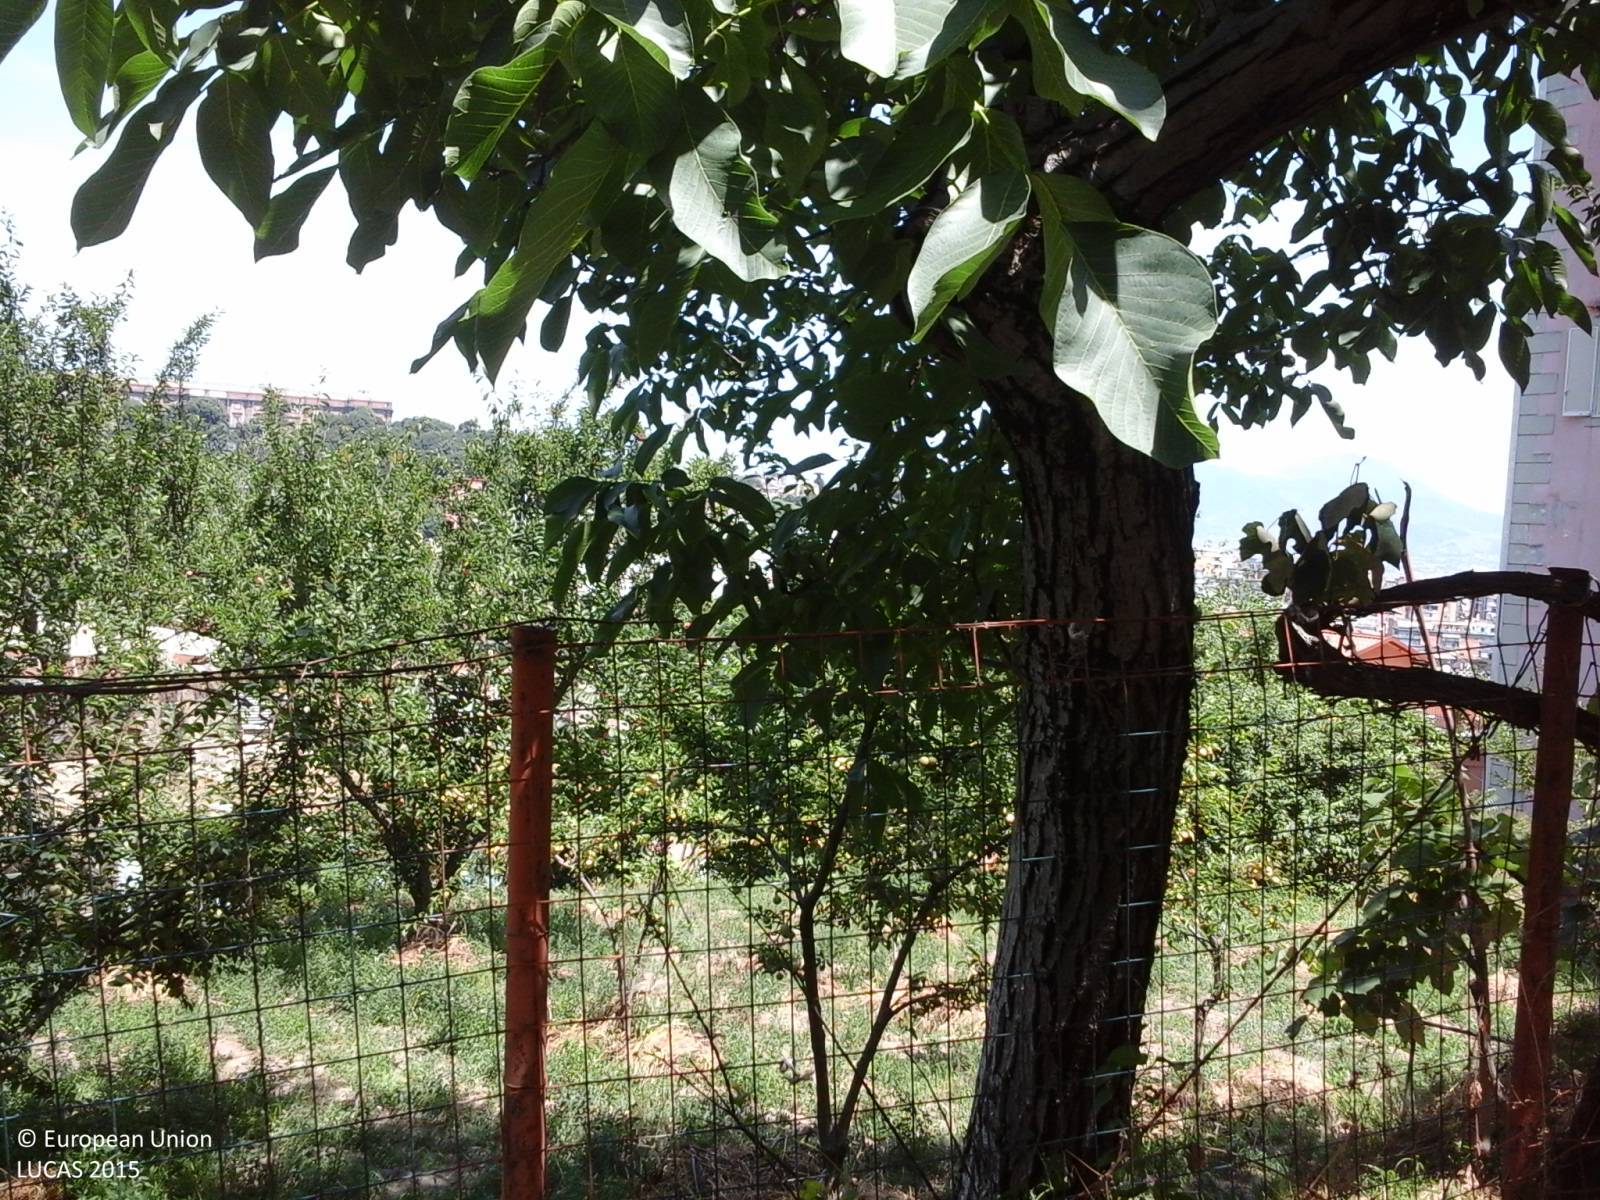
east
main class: Cropland
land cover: Other fruit trees and berries
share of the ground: > 75 %
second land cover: Spontaneously vegetated surfaces
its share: > 75 %
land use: Agriculture (excluding fallow land and kitchen gardens)
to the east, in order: Other fruit trees and berries; Spontaneously vegetated surfaces; Abandoned hedges; Artificial constructions in urban areas; Broadleaved woodland; Shrubland with sparse tree cover; Artificial constructions in urban areas
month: June
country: IT
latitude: 40.8641
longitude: 14.2415
